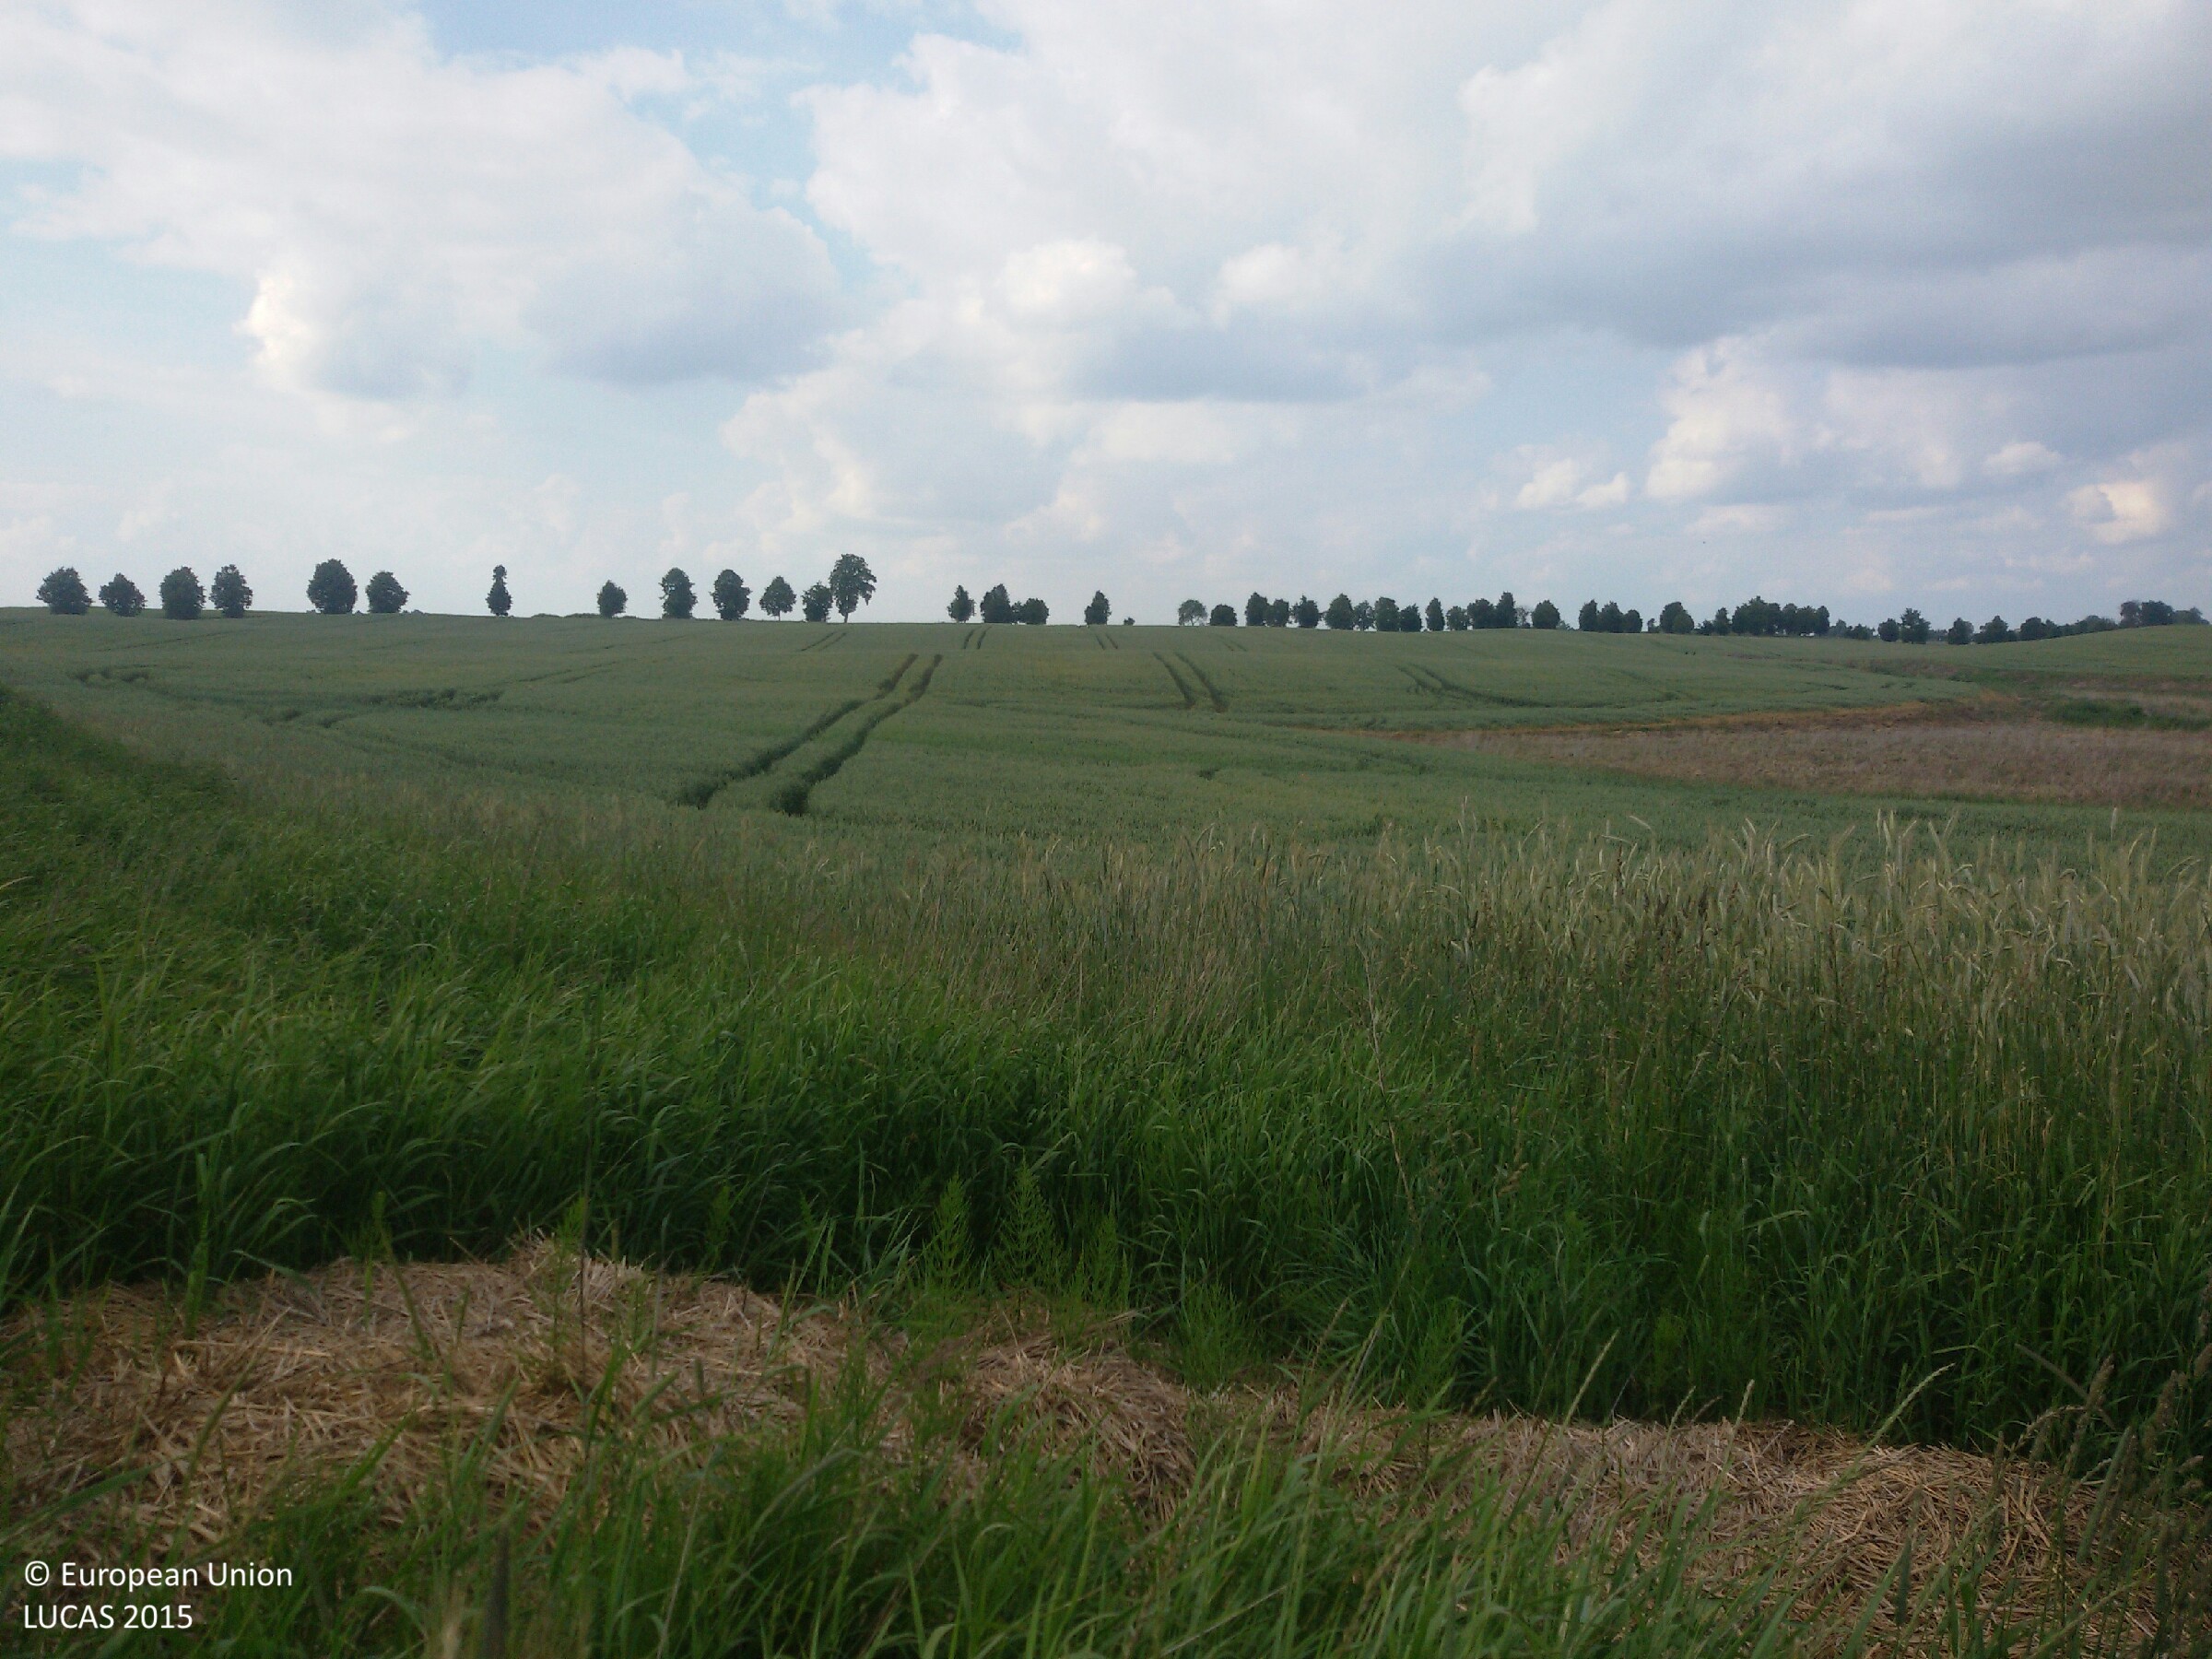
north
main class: Cropland
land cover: Rye
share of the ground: > 75 %
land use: Agriculture (excluding fallow land and kitchen gardens)
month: June
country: PL
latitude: 53.6611
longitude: 19.2706
